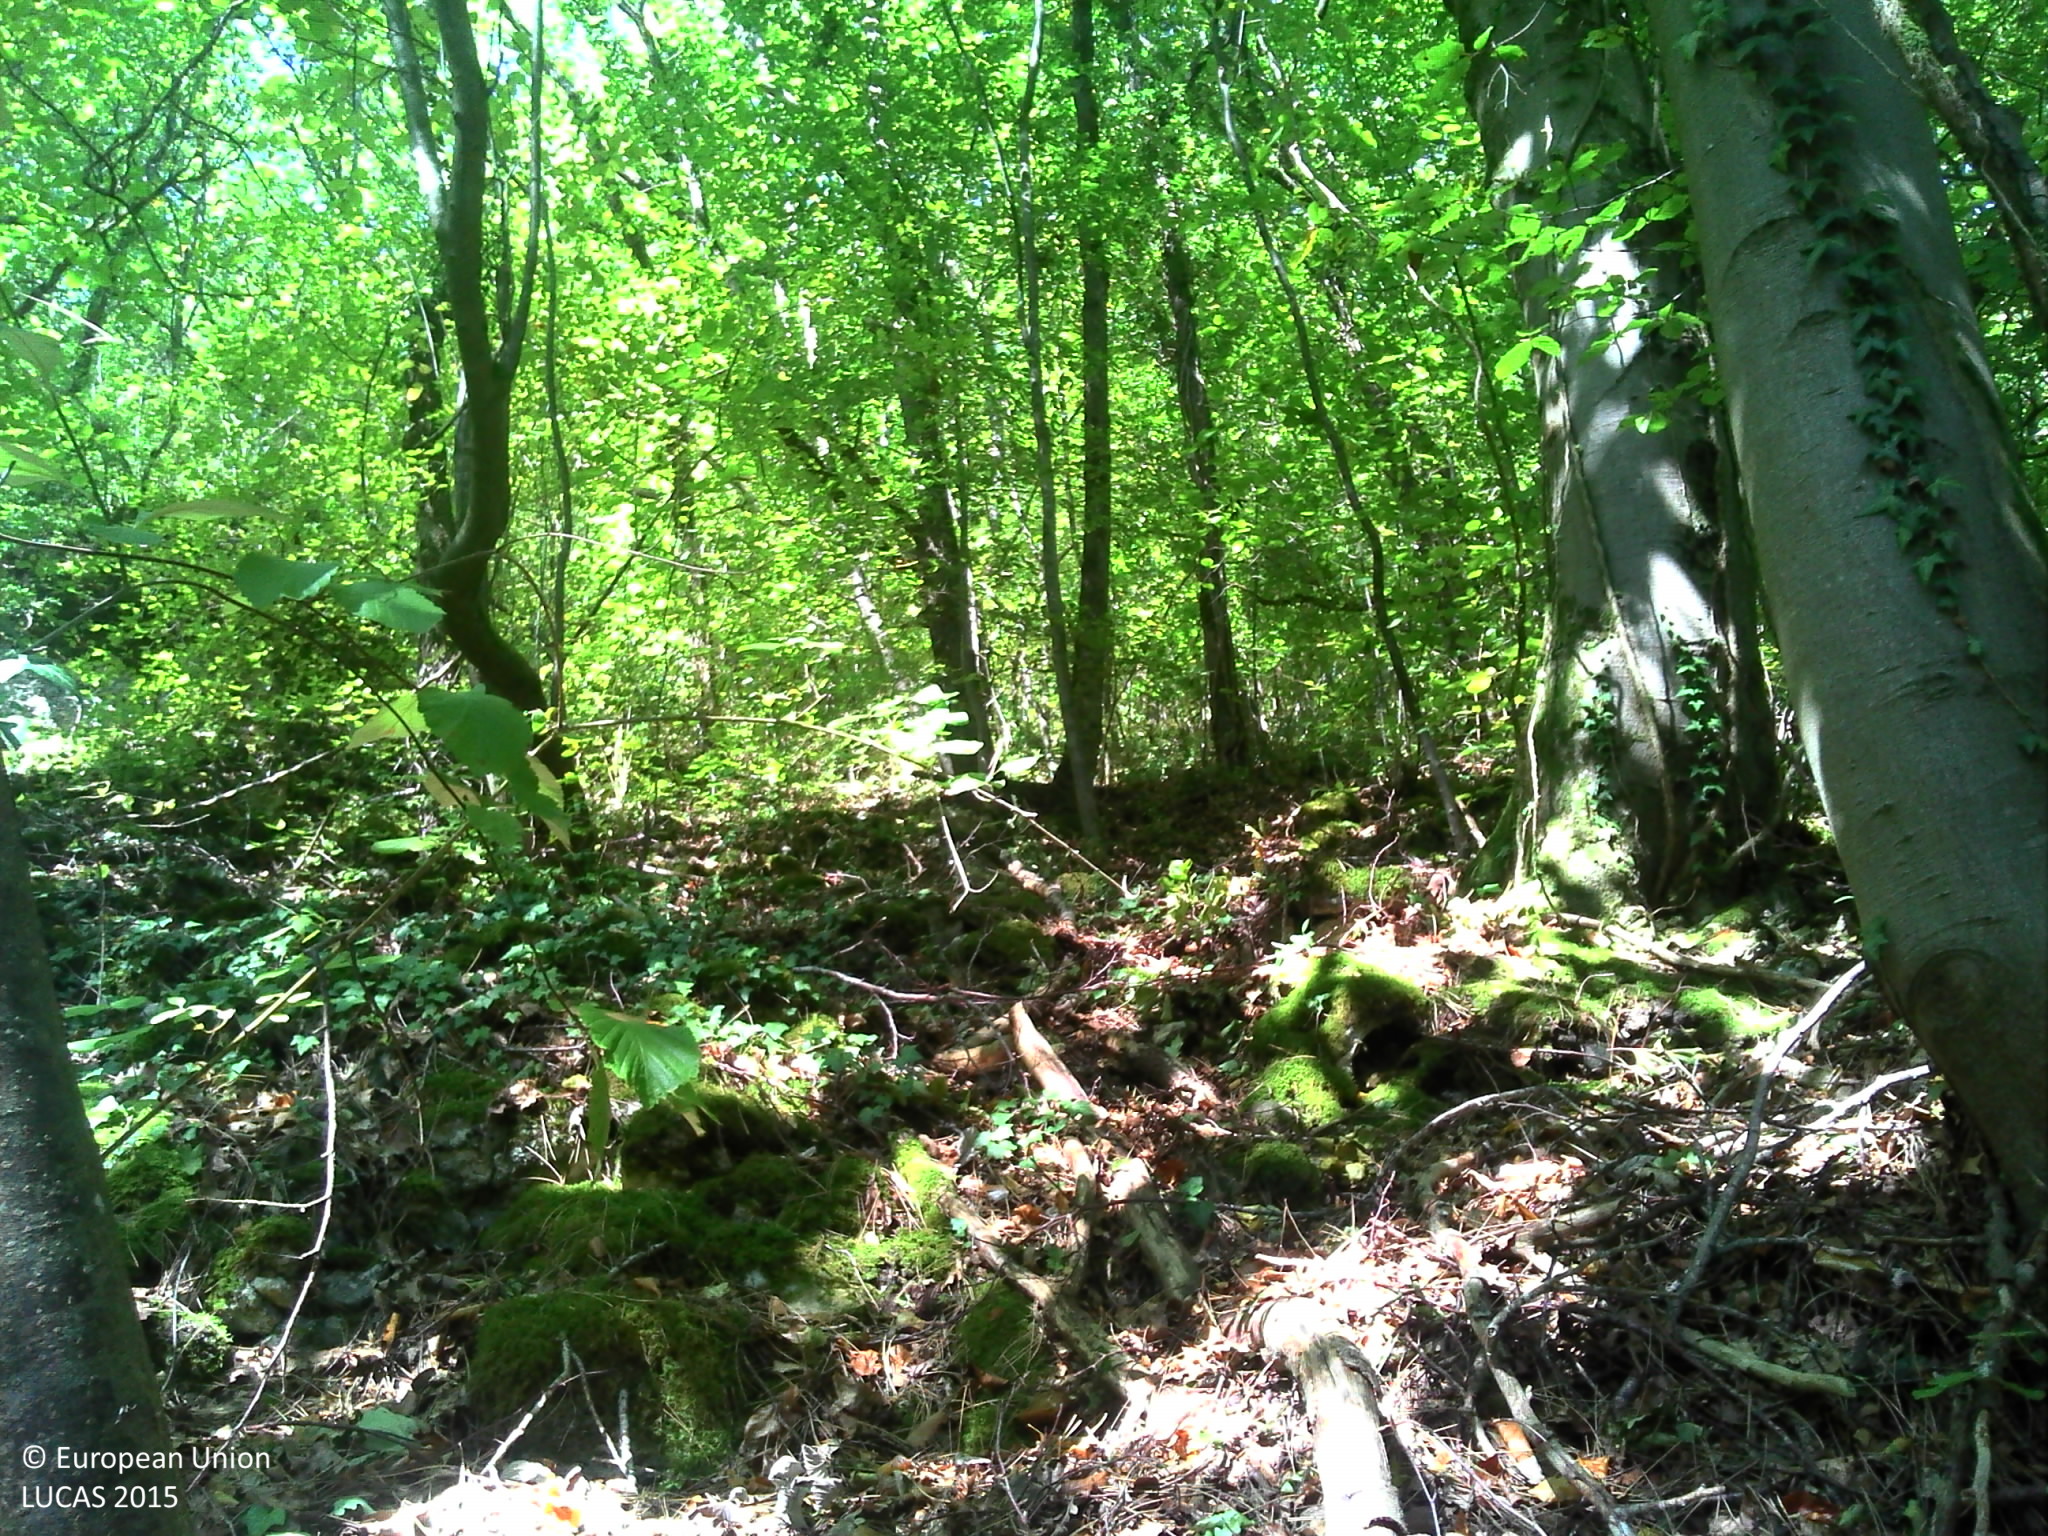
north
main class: Woodland
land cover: Pine dominated mixed woodland
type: hemiboreal forest and nemoral coniferous forest and mixed broadleaved-coniferous forest
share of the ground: > 75 %
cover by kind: coniferous forest trees 45 %, broadleaved forest trees 40 %, herbaceous plants 10 %, consolidated bare surface 5 %
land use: Forestry
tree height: > 5 m
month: October
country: FR
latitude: 48.9945
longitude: 5.9129
